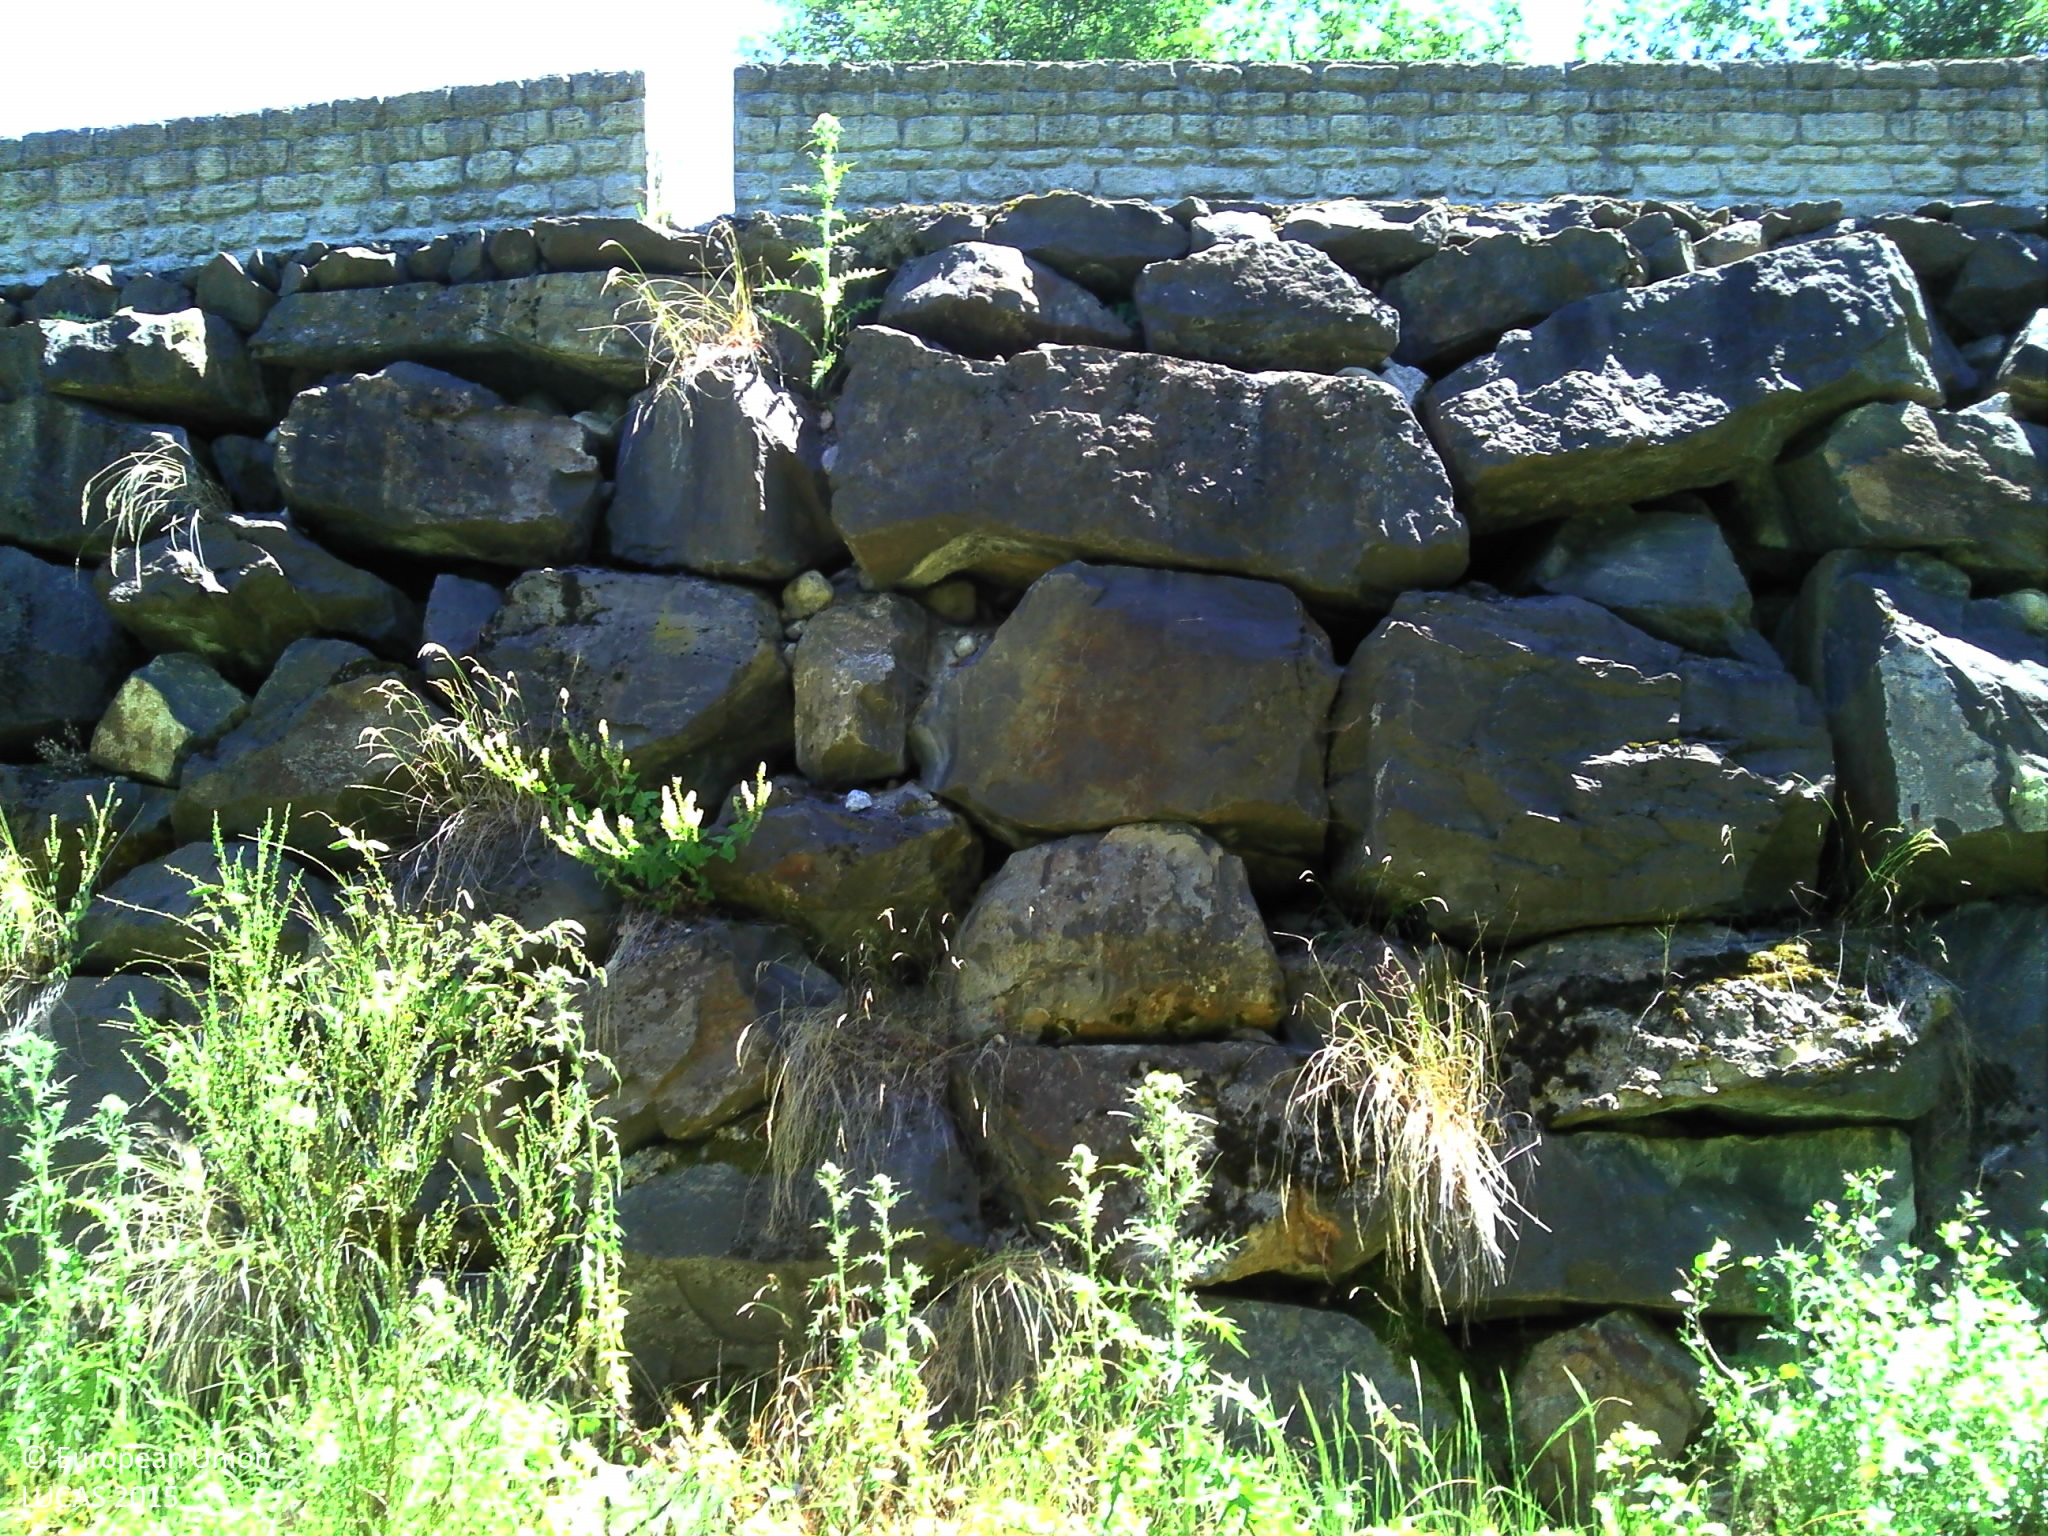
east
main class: Woodland
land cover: Broadleaved woodland
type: mesophytic deciduous forest
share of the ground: > 75 %
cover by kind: broadleaved forest trees 100 %
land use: Semi-natural and natural areas not in use
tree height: > 5 m
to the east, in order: Broadleaved woodland
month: July
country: FR
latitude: 42.6926
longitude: 2.1373
